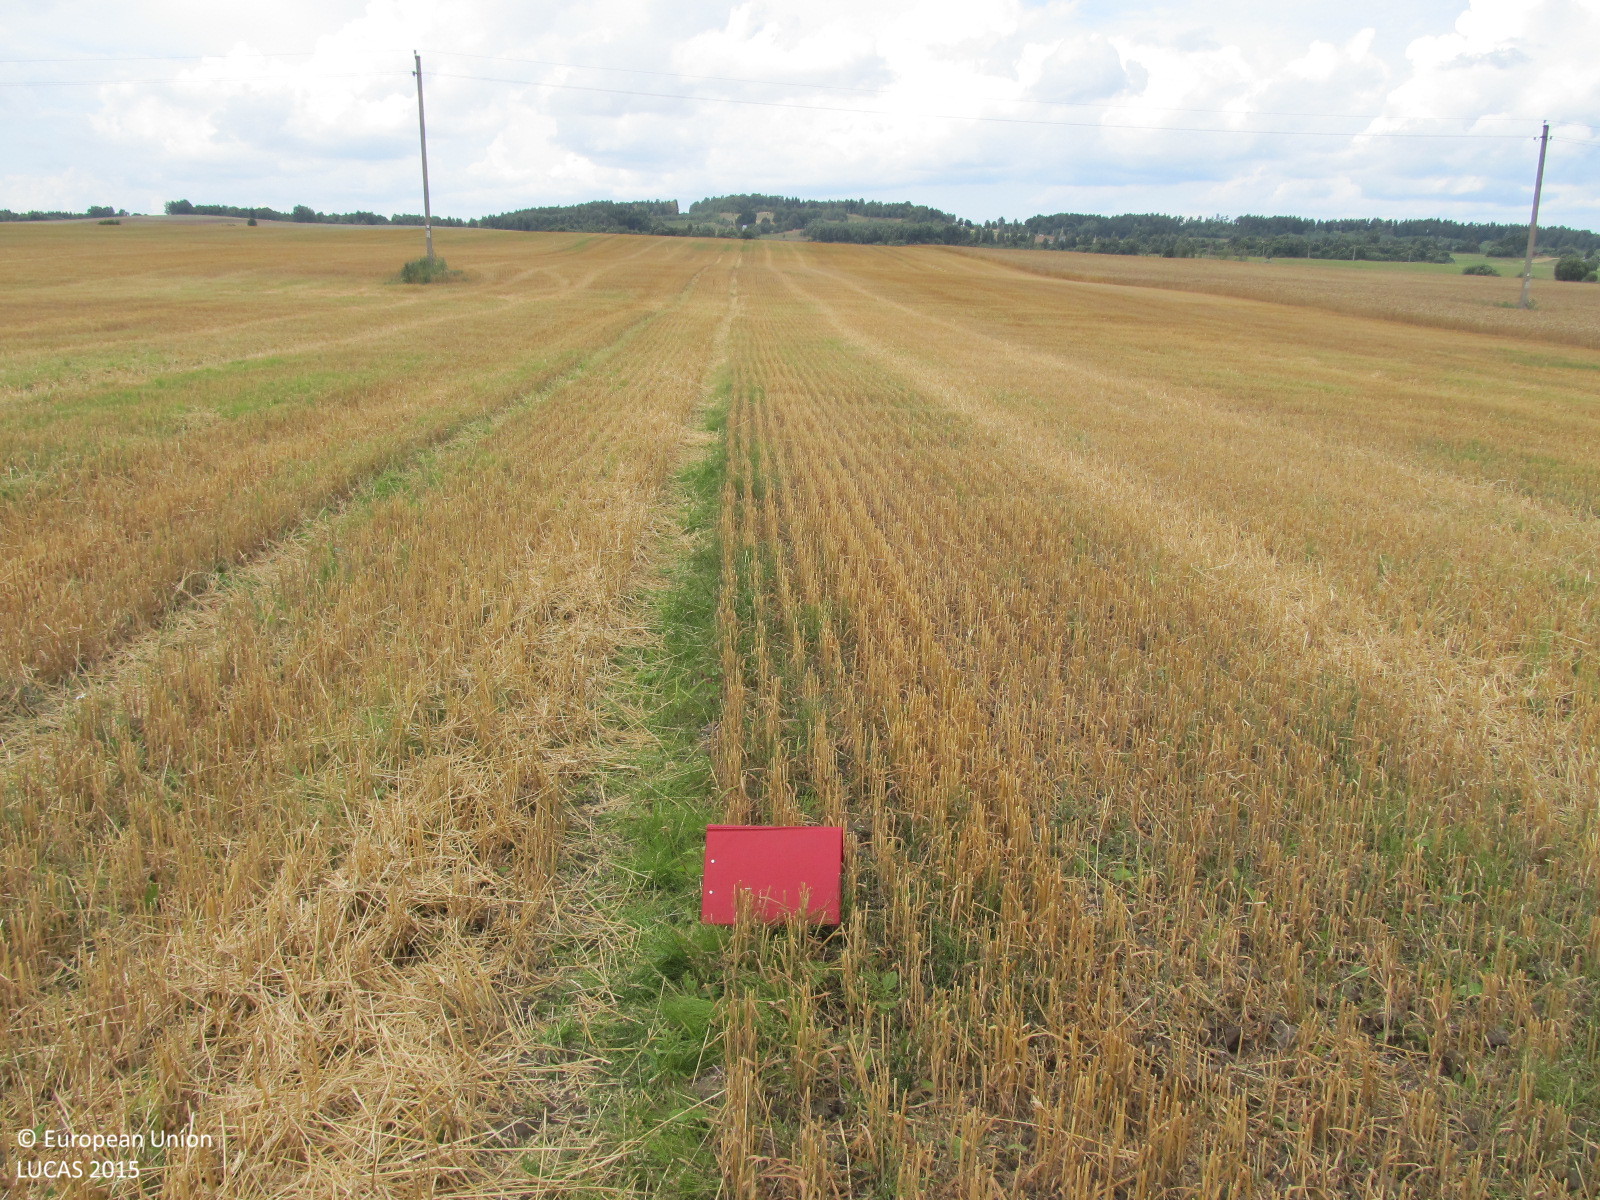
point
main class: Cropland
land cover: Common wheat
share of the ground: > 75 %
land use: Agriculture (excluding fallow land and kitchen gardens)
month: August
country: LT
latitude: 55.6868
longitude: 23.0008
